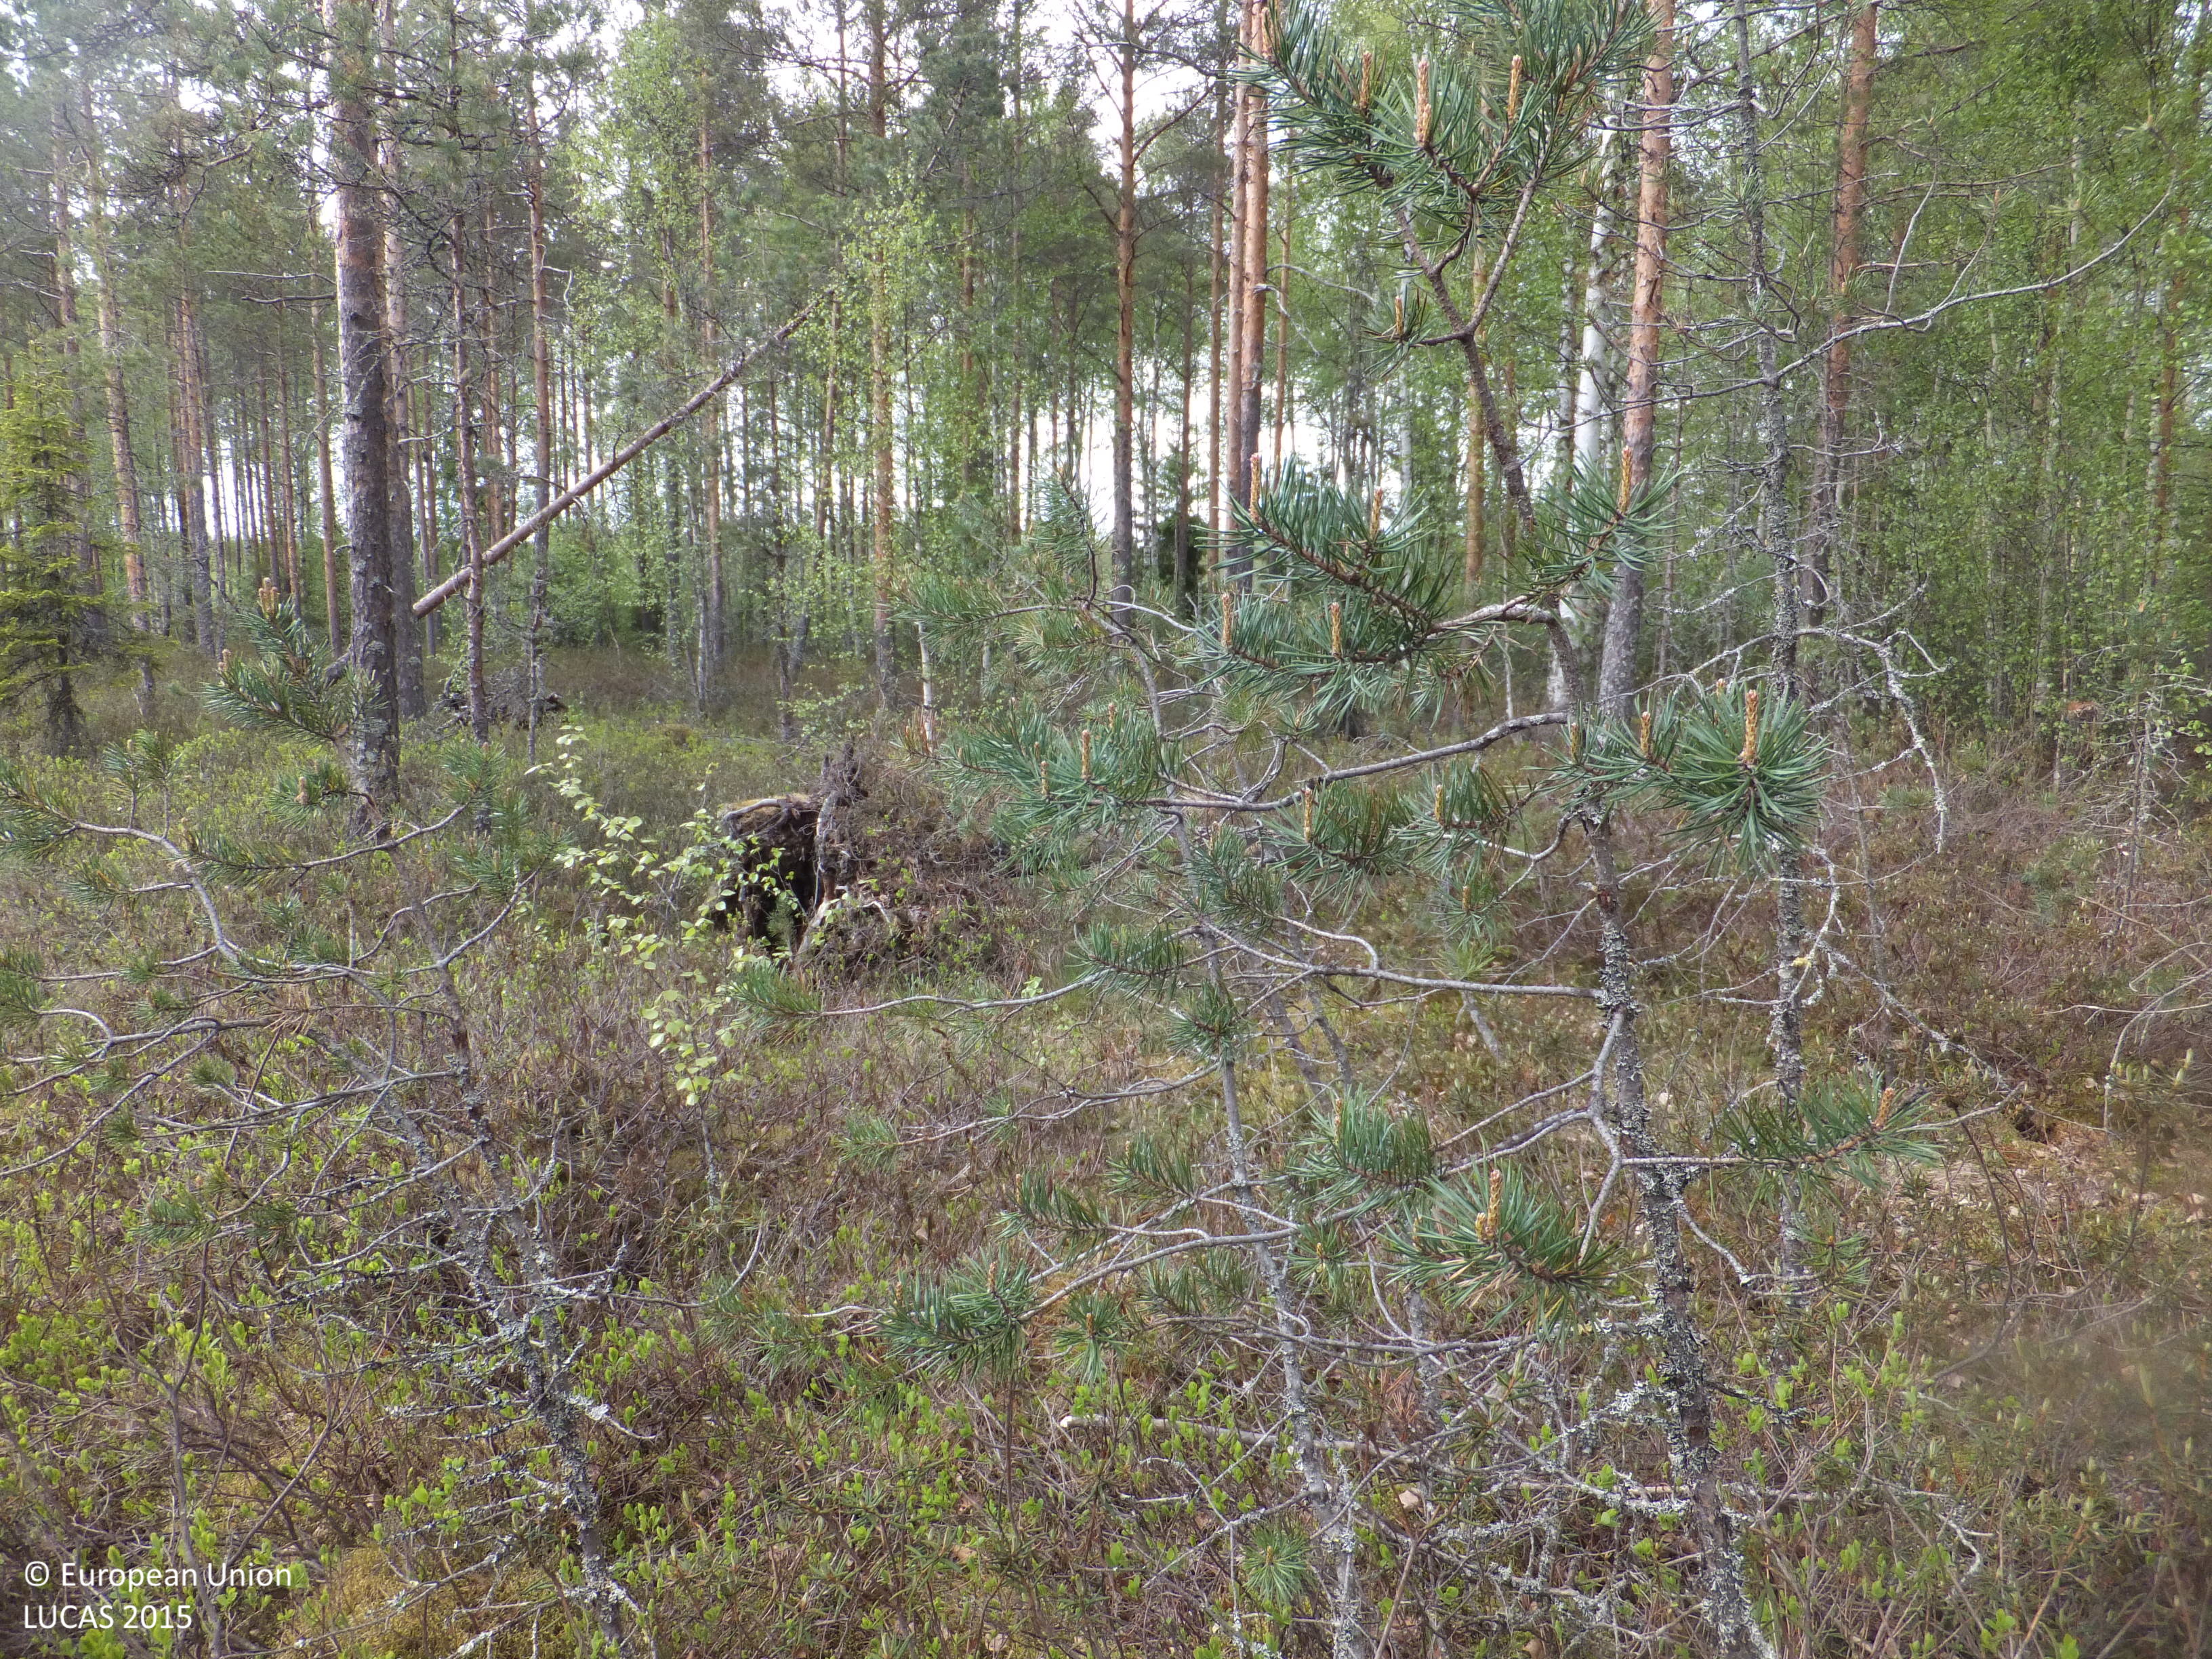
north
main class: Woodland
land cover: Pine dominated coniferous woodland
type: boreal forest
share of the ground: > 75 %
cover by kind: coniferous forest trees 80 %, shrubs 10 %, broadleaved forest trees 5 %, lichens and mosses 5 %
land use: Forestry
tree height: > 5 m
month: June
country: FI
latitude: 63.5470
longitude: 23.2365
